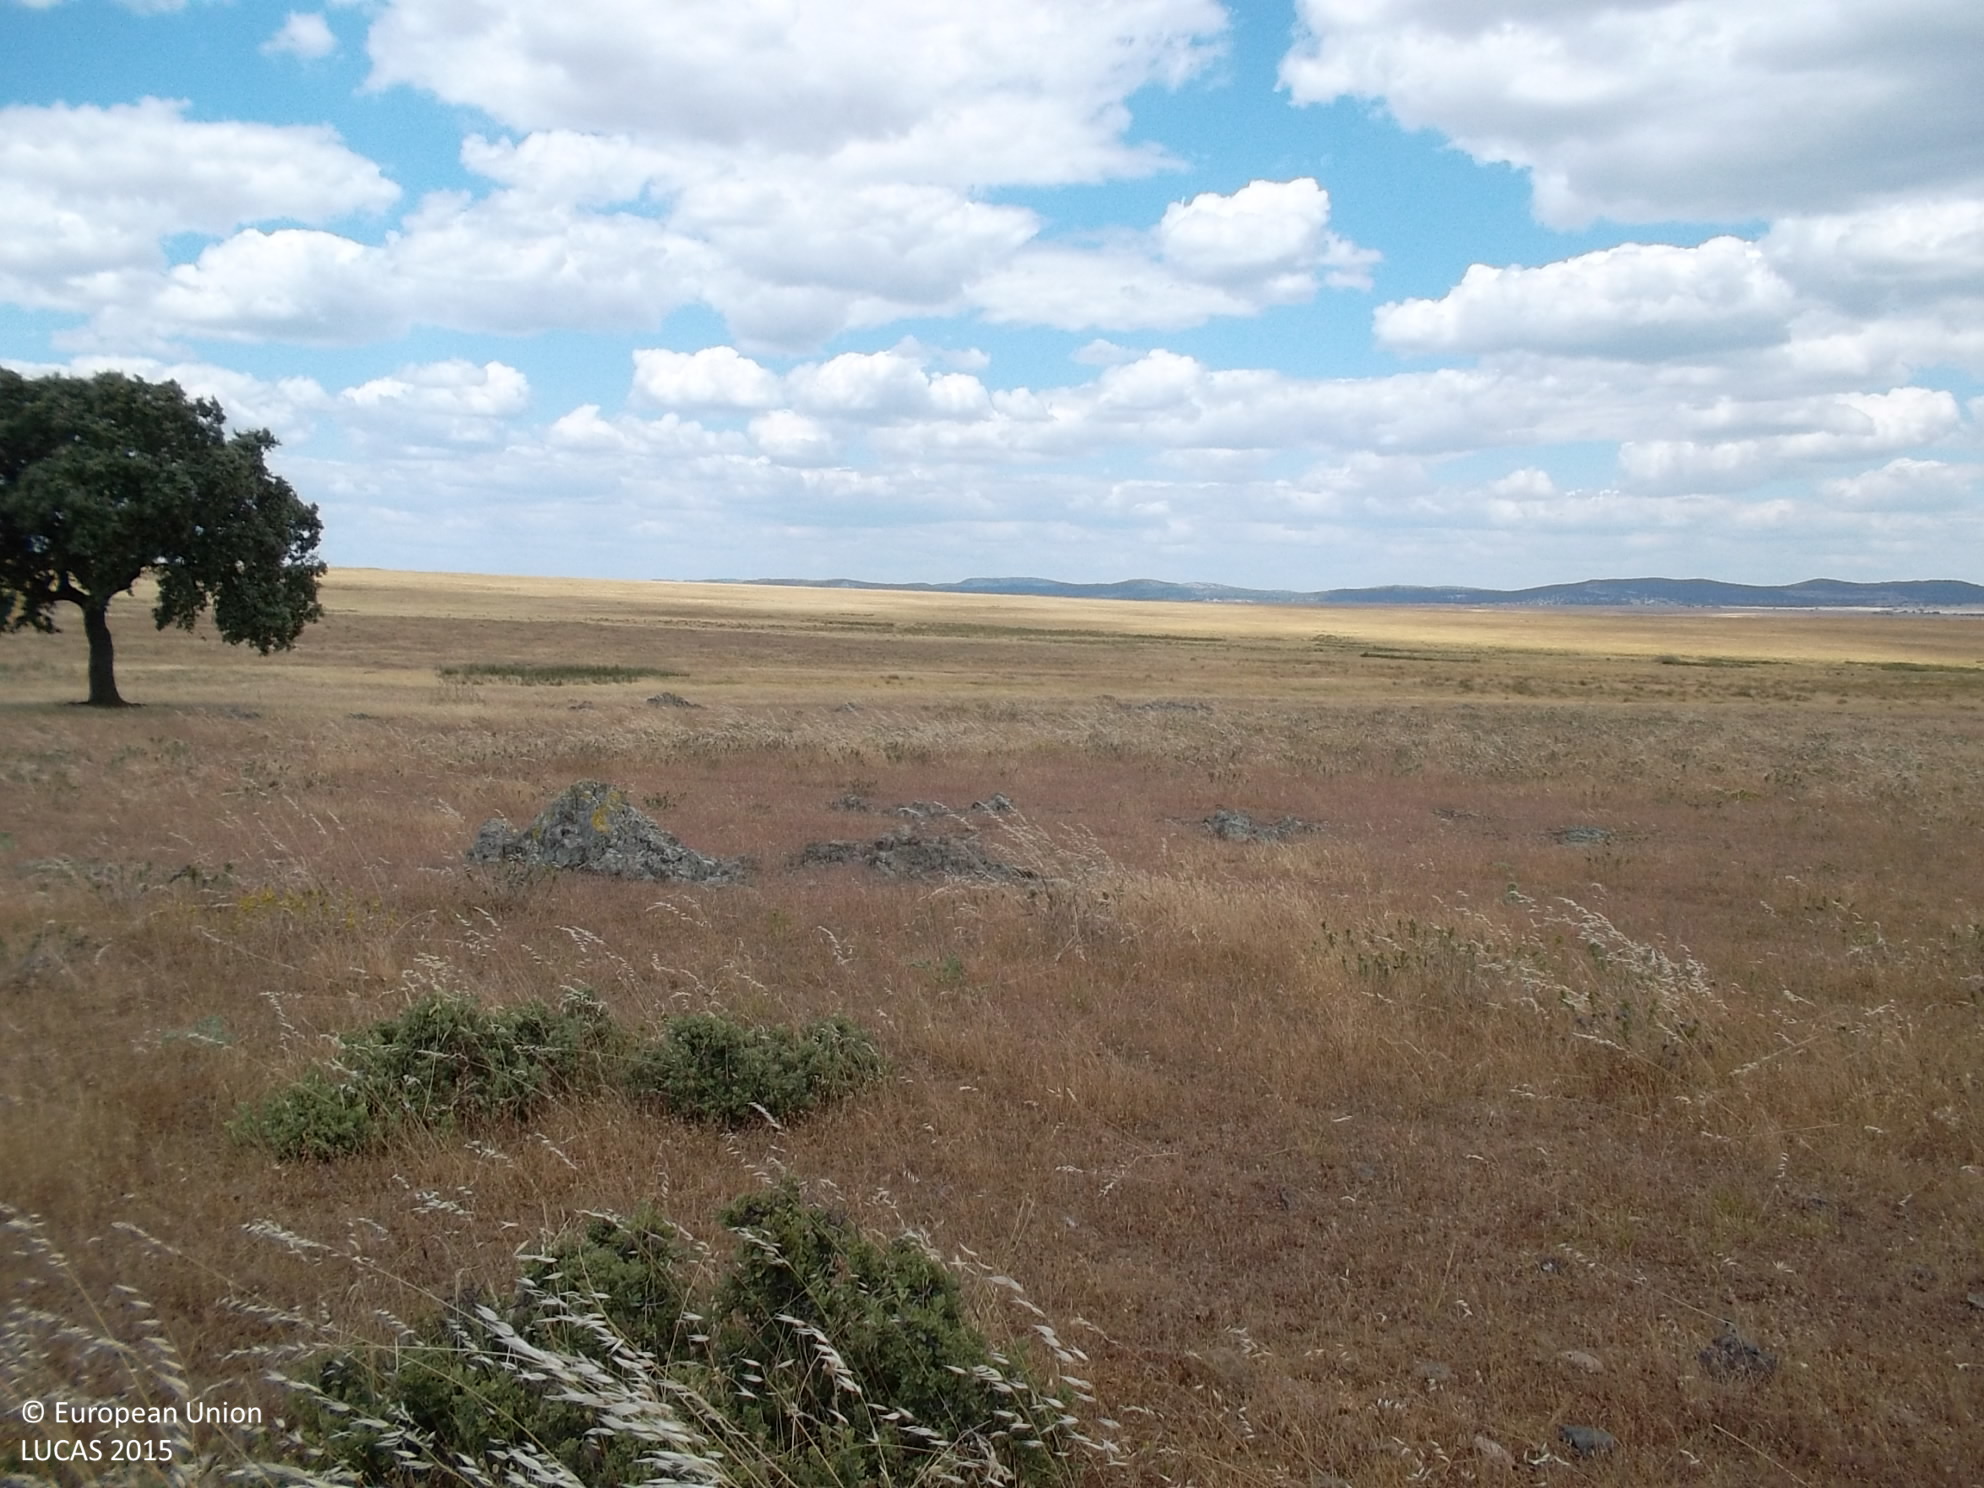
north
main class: Grassland
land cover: Grassland without tree/shrub cover
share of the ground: > 75 %
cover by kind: herbaceous plants 100 %
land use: Agriculture (excluding fallow land and kitchen gardens)
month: May
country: ES
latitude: 38.5778
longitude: -4.3801
